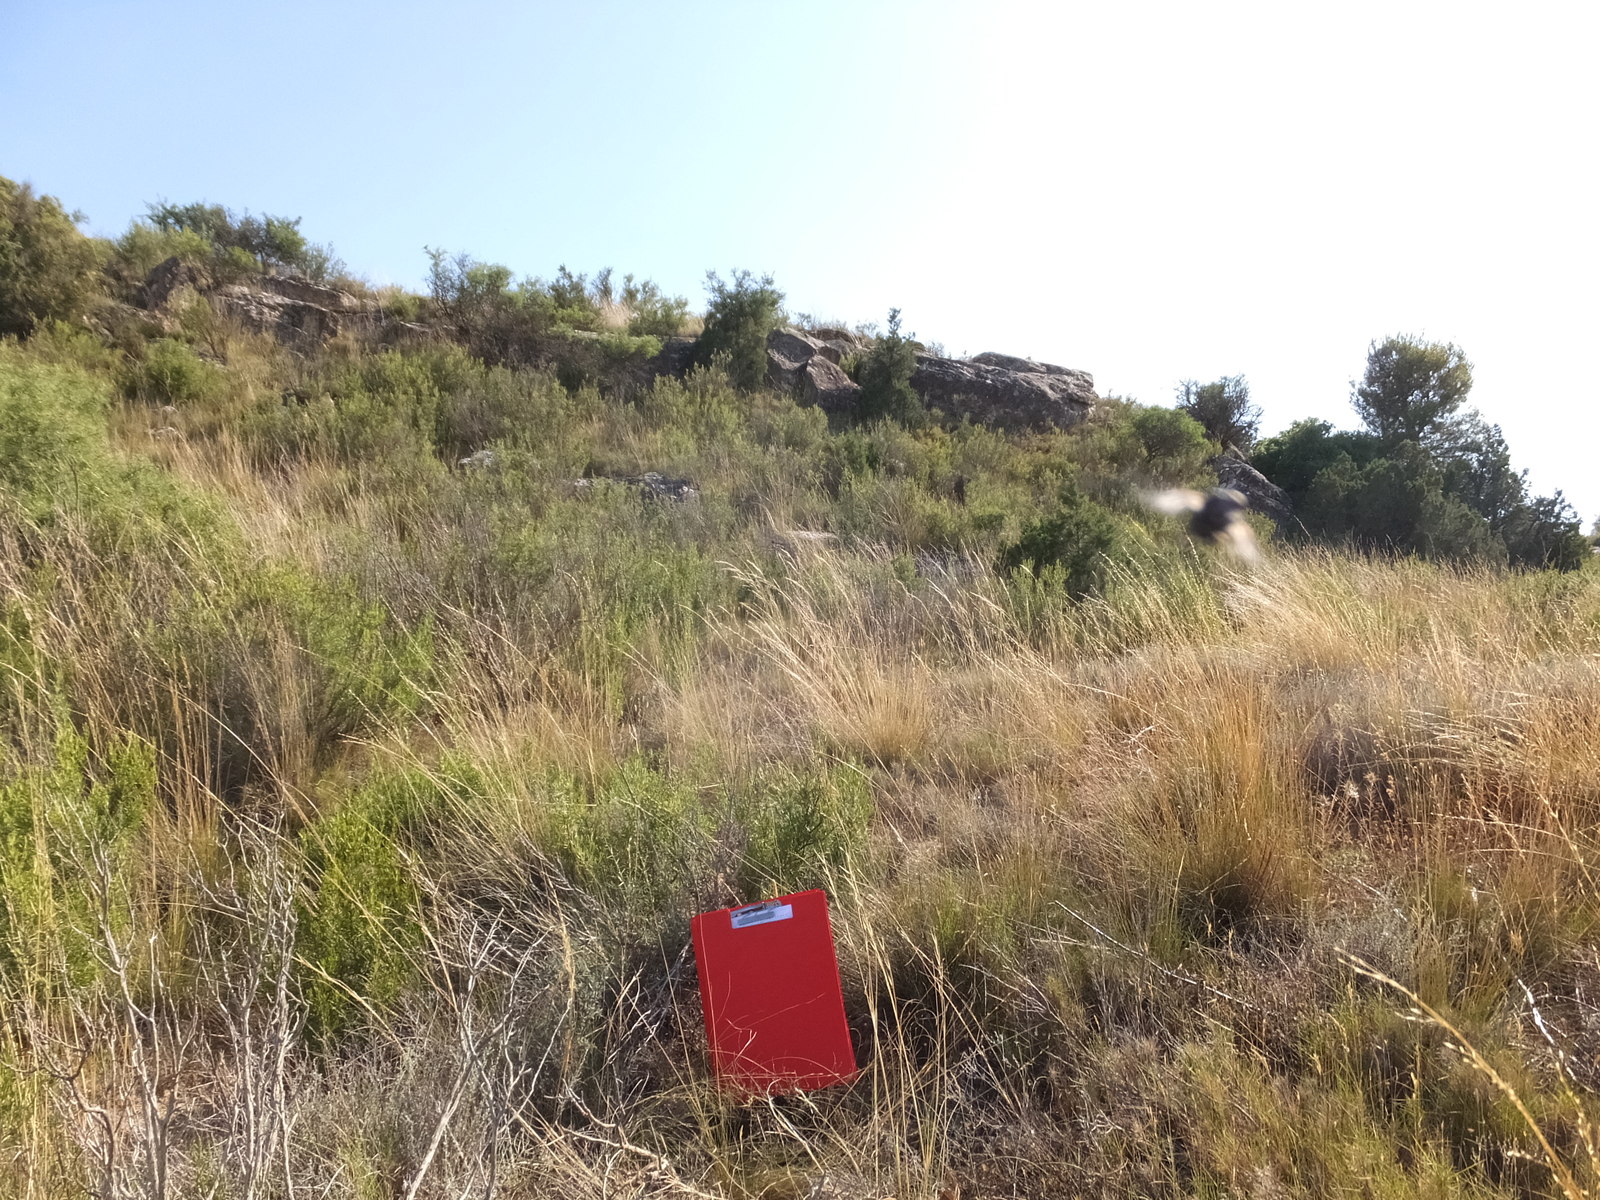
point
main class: Shrubland
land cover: Shrubland without tree cover
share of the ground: > 75 %
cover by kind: shrubs 50 %, herbaceous plants 50 %
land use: Semi-natural and natural areas not in use
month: June
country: ES
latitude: 41.2087
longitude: -0.2101
